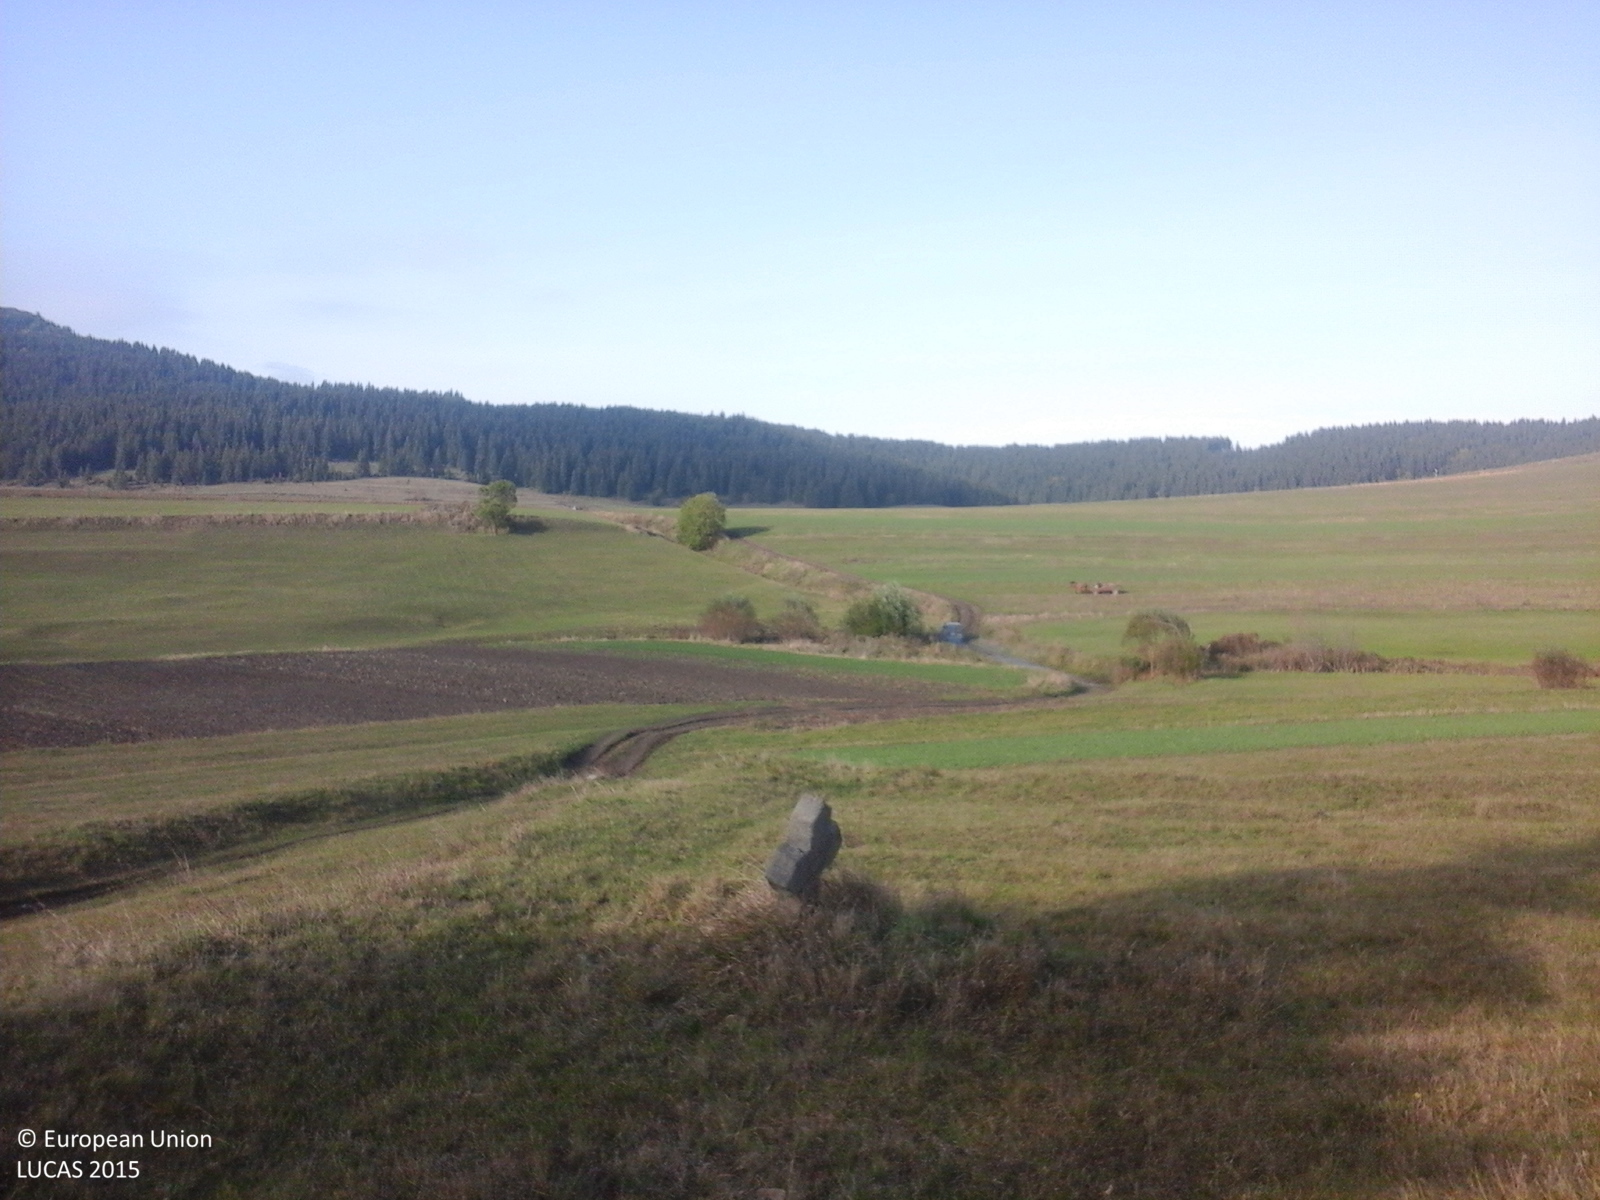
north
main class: Grassland
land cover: Grassland without tree/shrub cover
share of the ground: > 75 %
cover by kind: herbaceous plants 100 %
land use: Agriculture (excluding fallow land and kitchen gardens)
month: October
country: RO
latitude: 46.3516
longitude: 25.8531
